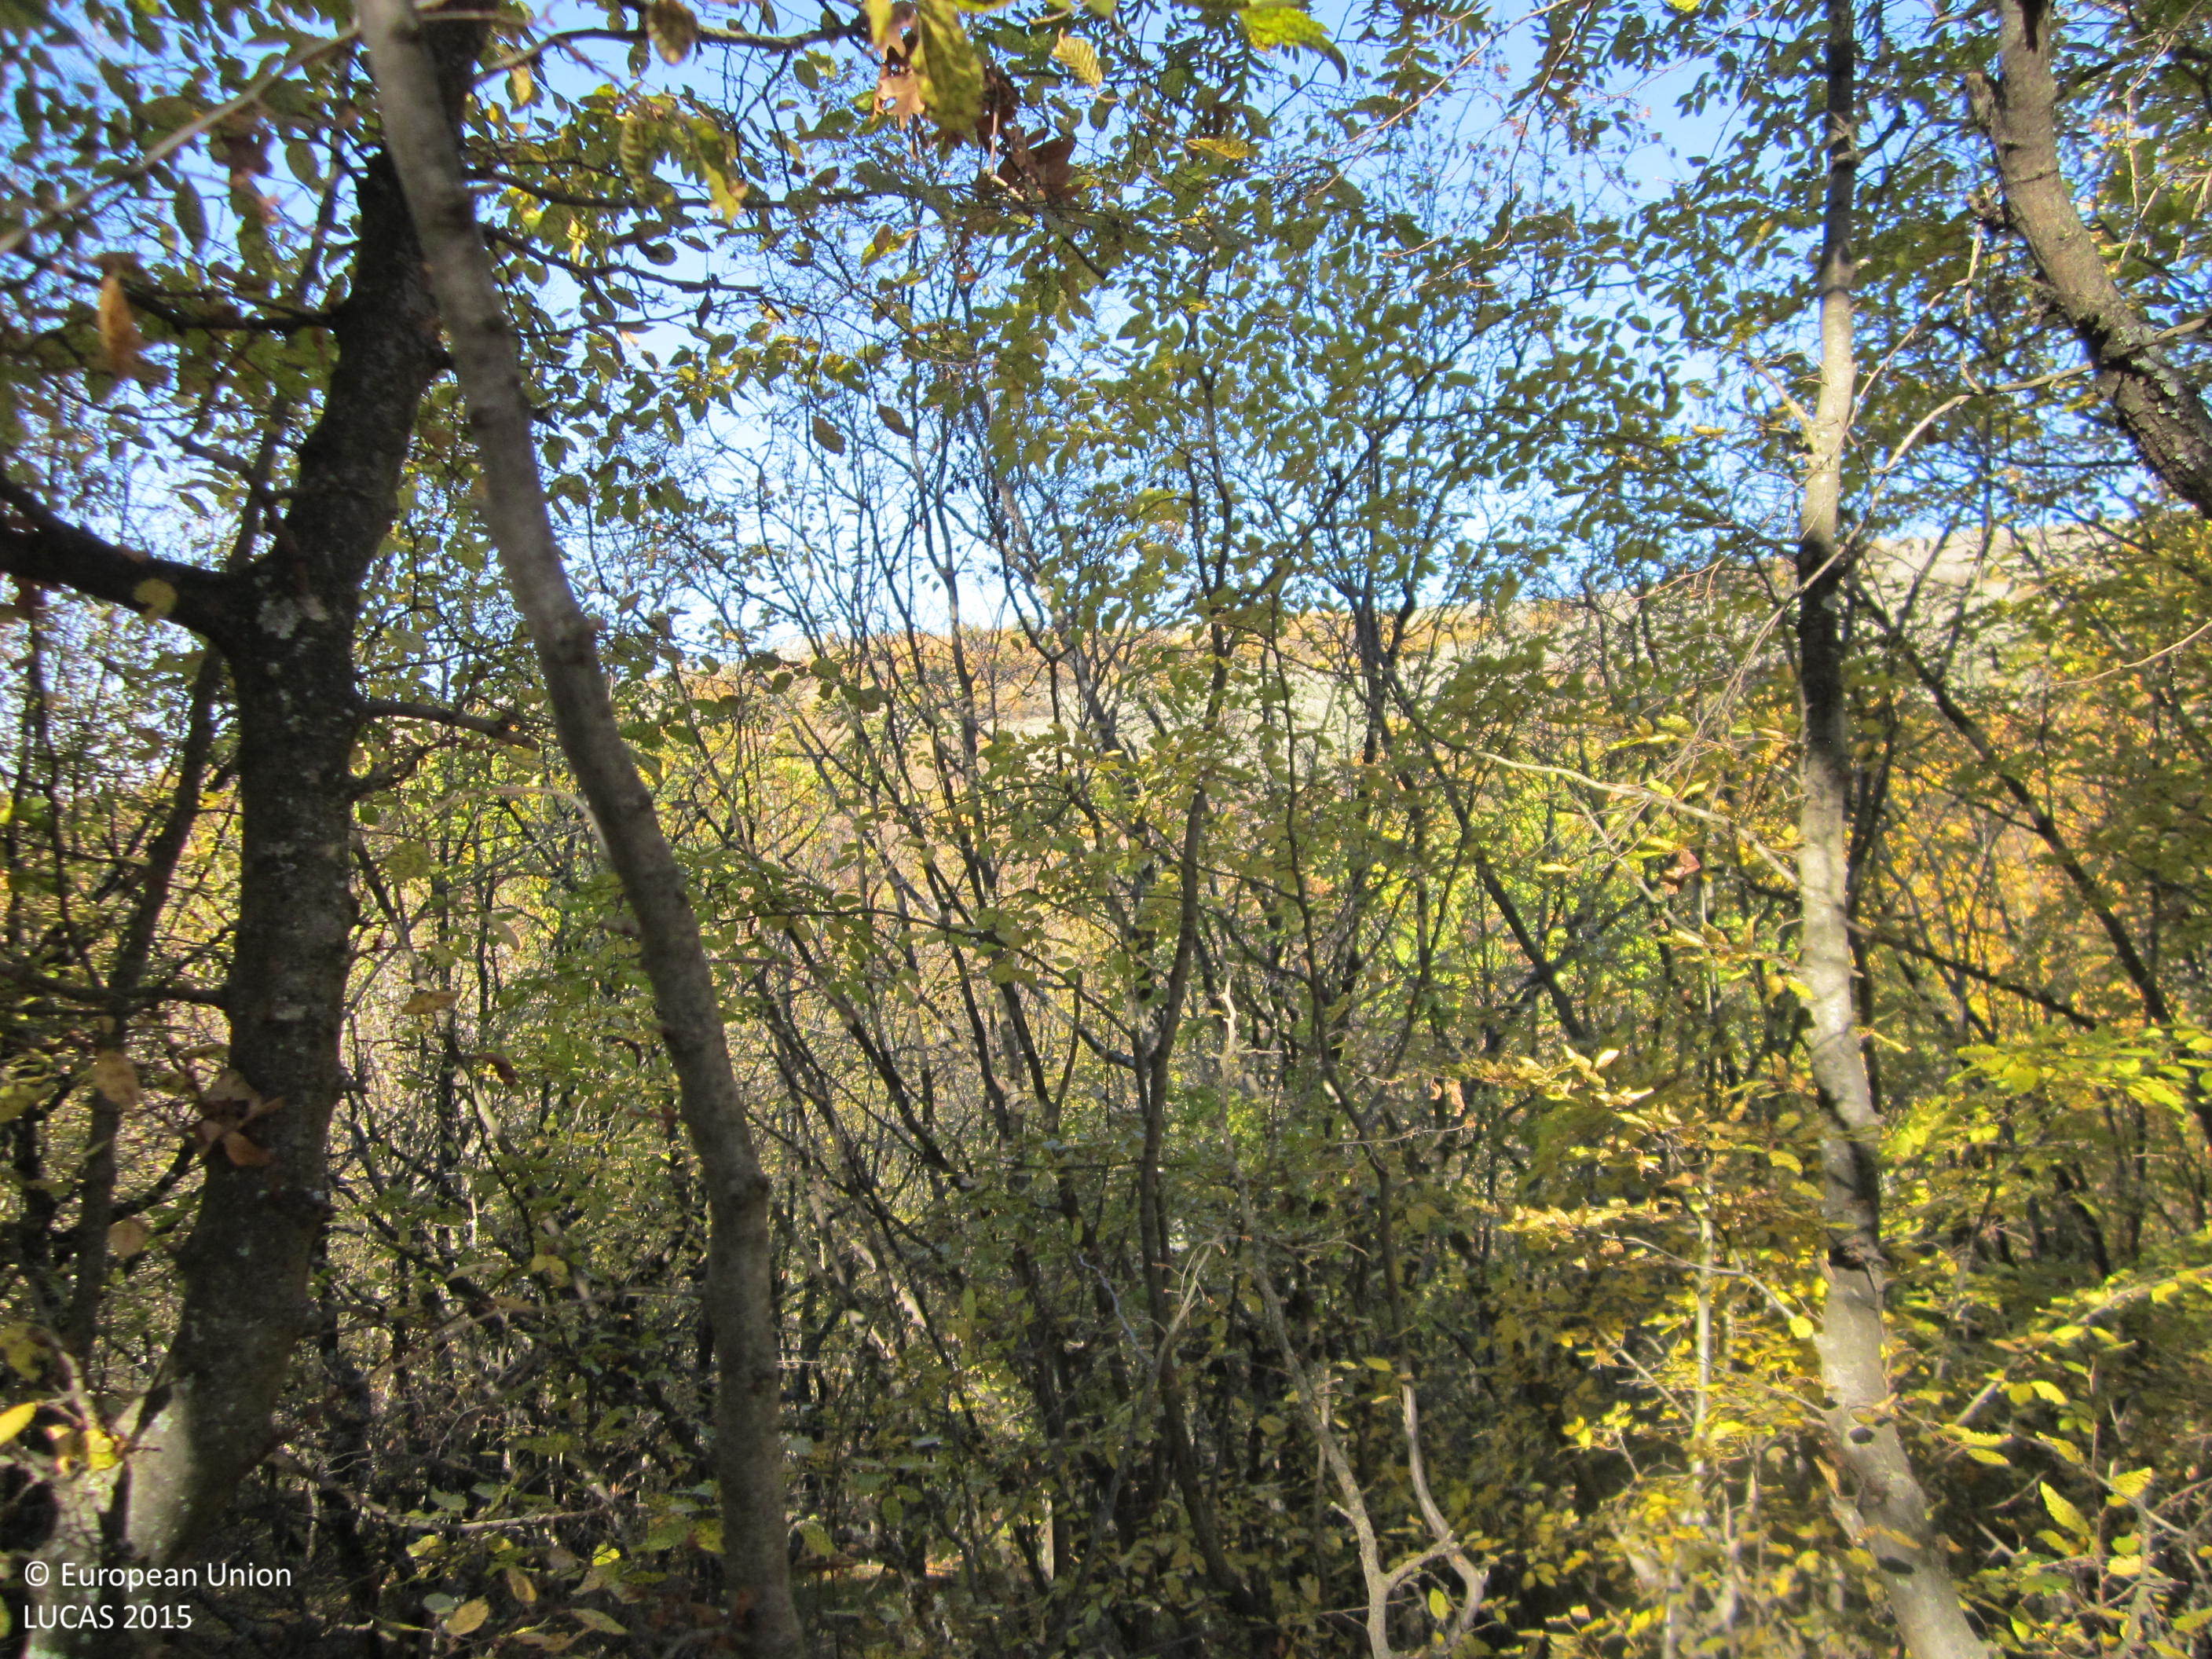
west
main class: Woodland
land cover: Broadleaved woodland
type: mesophytic deciduous forest
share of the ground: > 75 %
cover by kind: broadleaved forest trees 80 %, herbaceous plants 15 %, shrubs 5 %
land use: Forestry
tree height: > 5 m
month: November
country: BG
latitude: 41.4878
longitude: 25.7404
